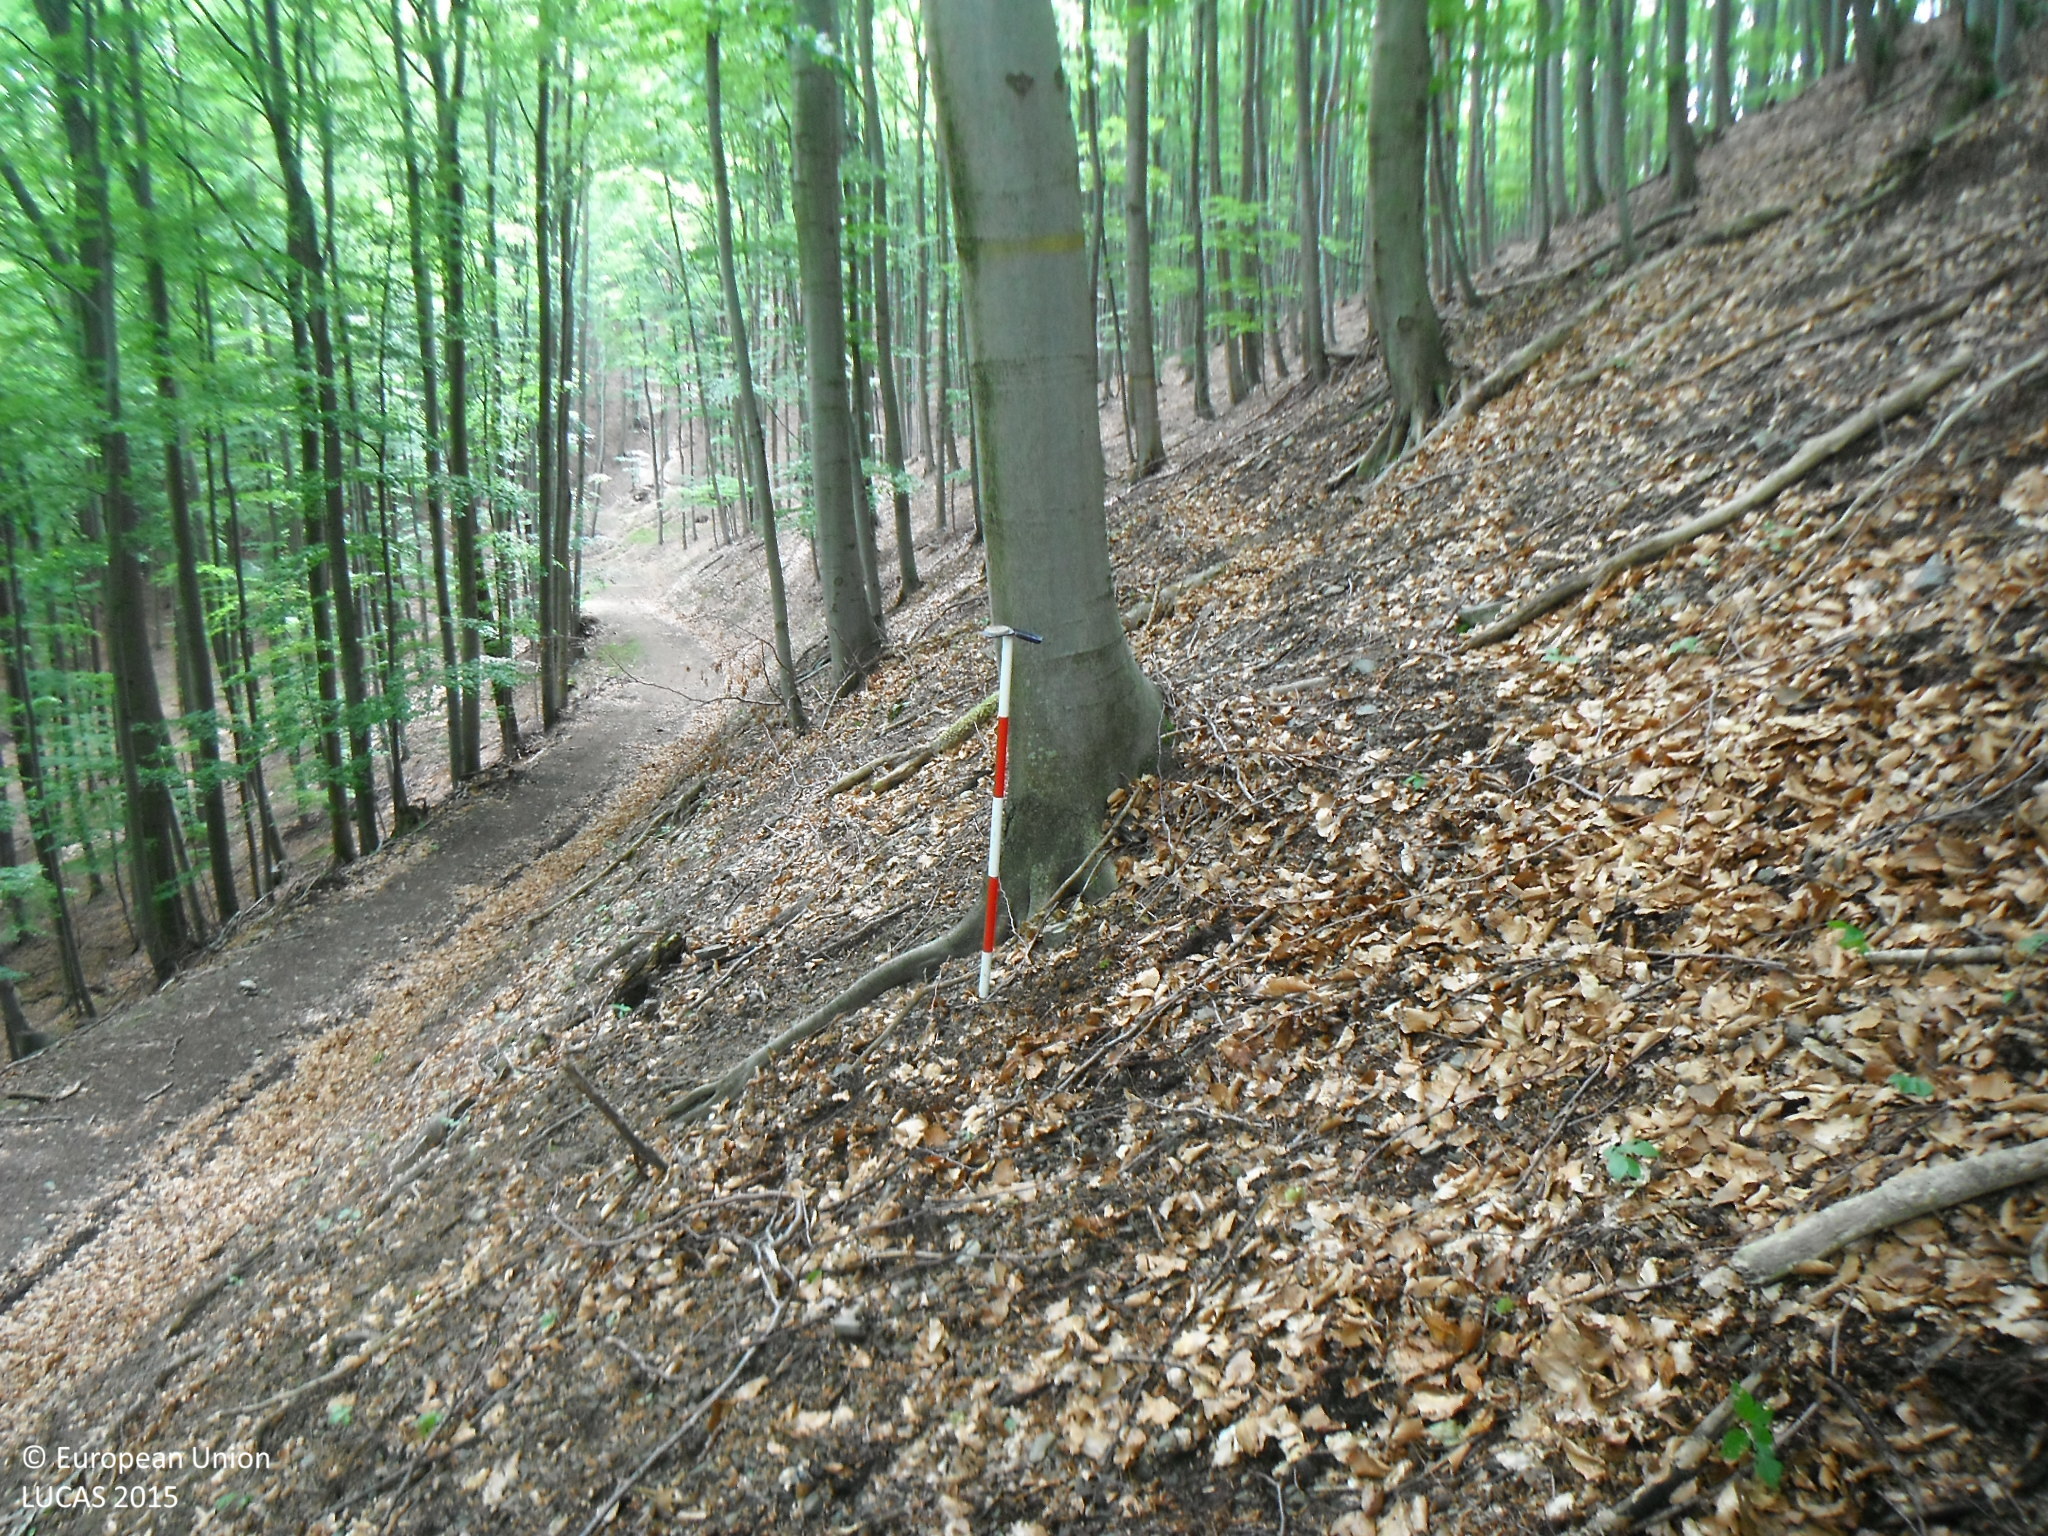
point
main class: Woodland
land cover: Broadleaved woodland
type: mountainous beech forest
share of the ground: > 75 %
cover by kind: broadleaved forest trees 100 %
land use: Forestry
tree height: > 5 m
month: May
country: SK
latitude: 48.4029
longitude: 17.2087
